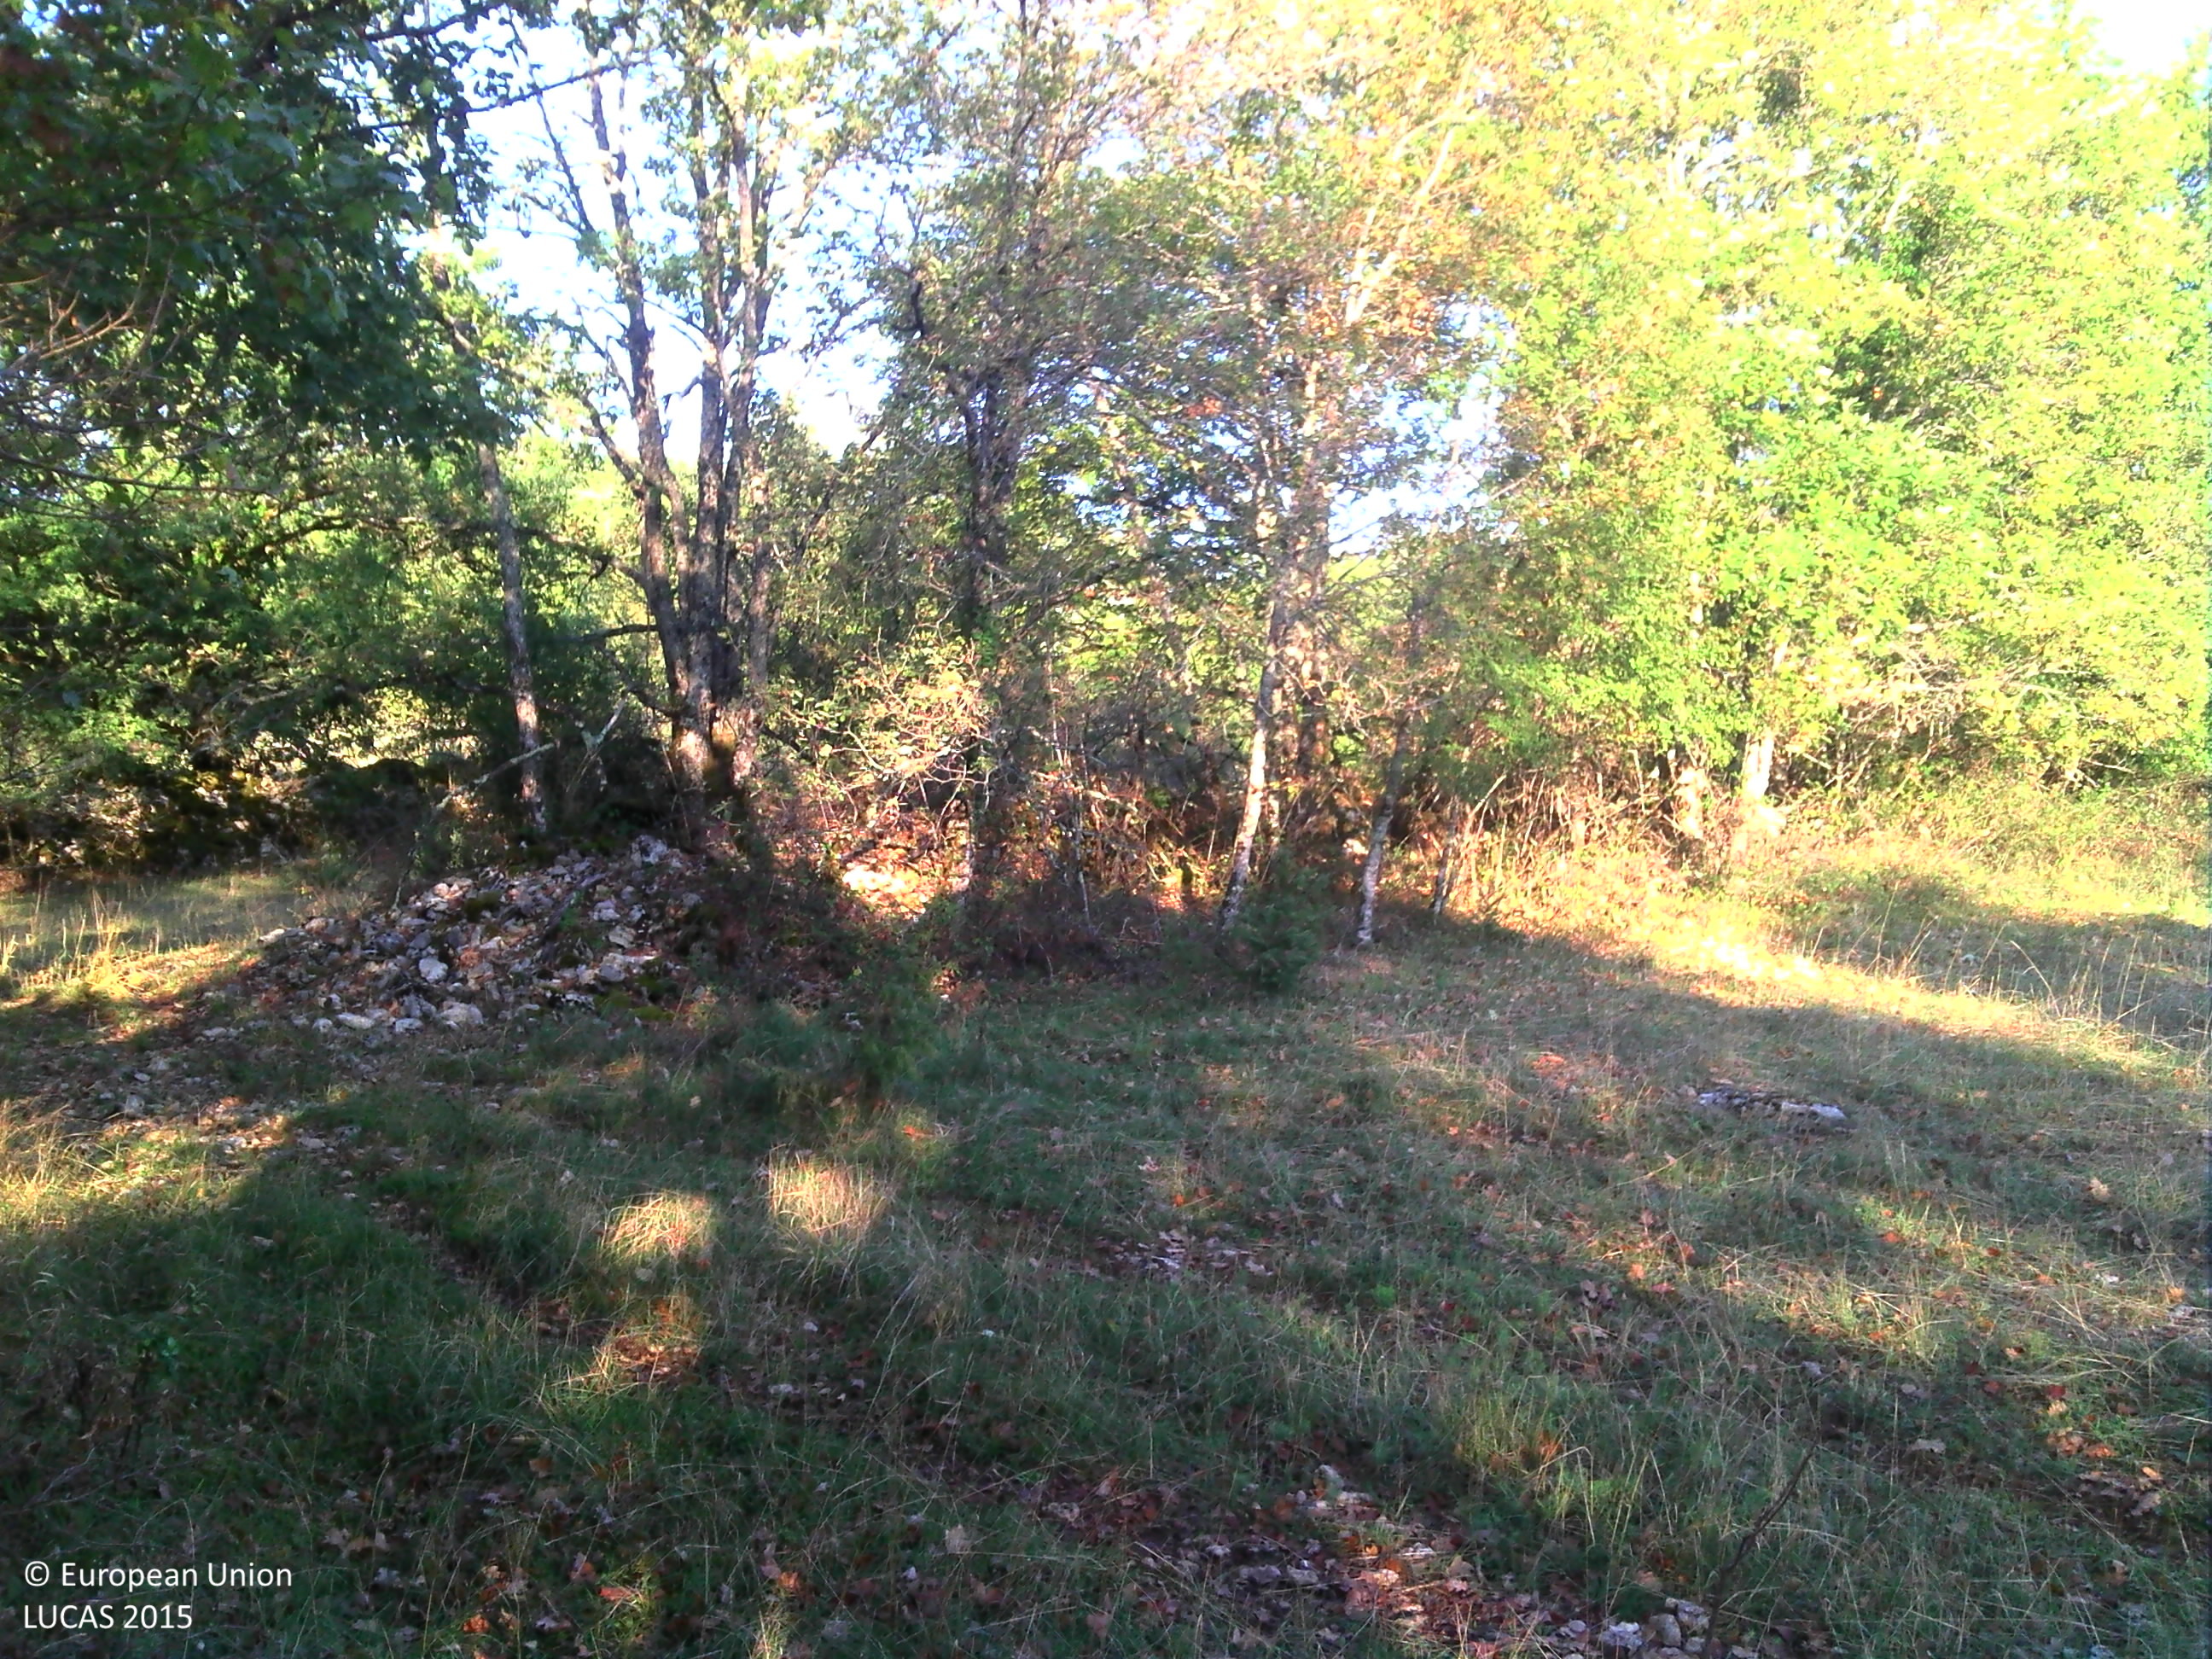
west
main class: Woodland
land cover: Broadleaved woodland
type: mesophytic deciduous forest
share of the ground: > 75 %
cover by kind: herbaceous plants 50 %, broadleaved forest trees 40 %, shrubs 10 %
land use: Forestry
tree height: > 5 m
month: September
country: FR
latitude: 44.6111
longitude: 1.6440
